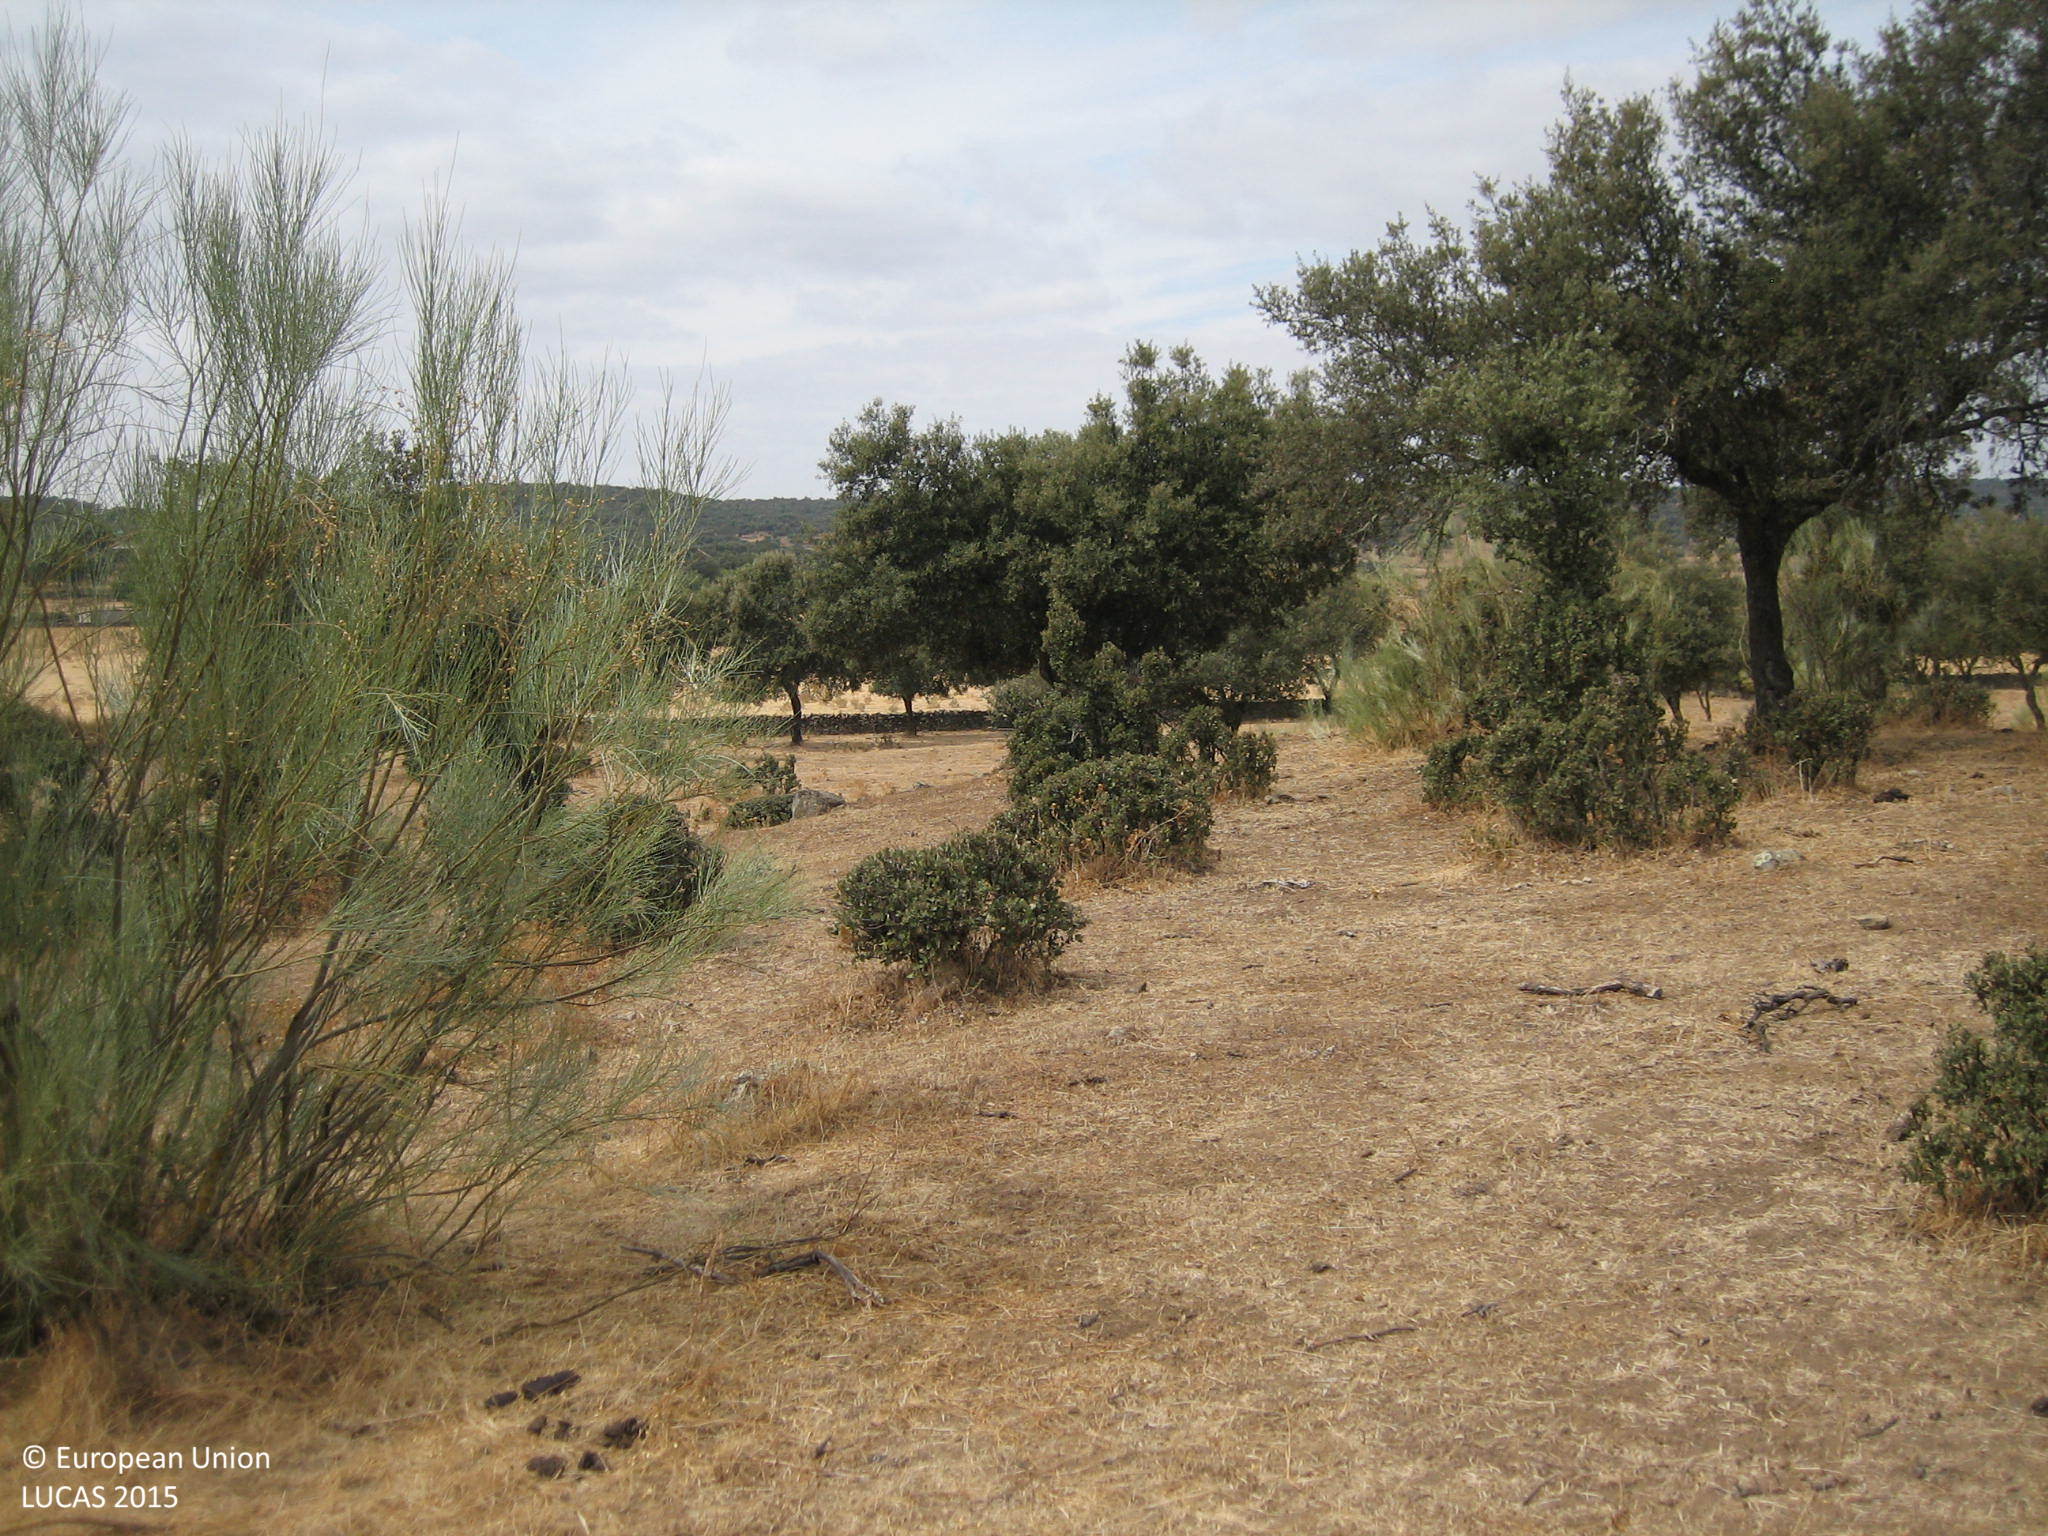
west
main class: Shrubland
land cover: Shrubland with sparse tree cover
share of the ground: 10 - 25 %
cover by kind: herbaceous plants 80 %, shrubs 15 %, broadleaved forest trees 5 %
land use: Forestry
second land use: Agriculture (excluding fallow land and kitchen gardens)
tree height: < 5 m
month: September
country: ES
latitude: 38.4974
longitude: -6.8815
